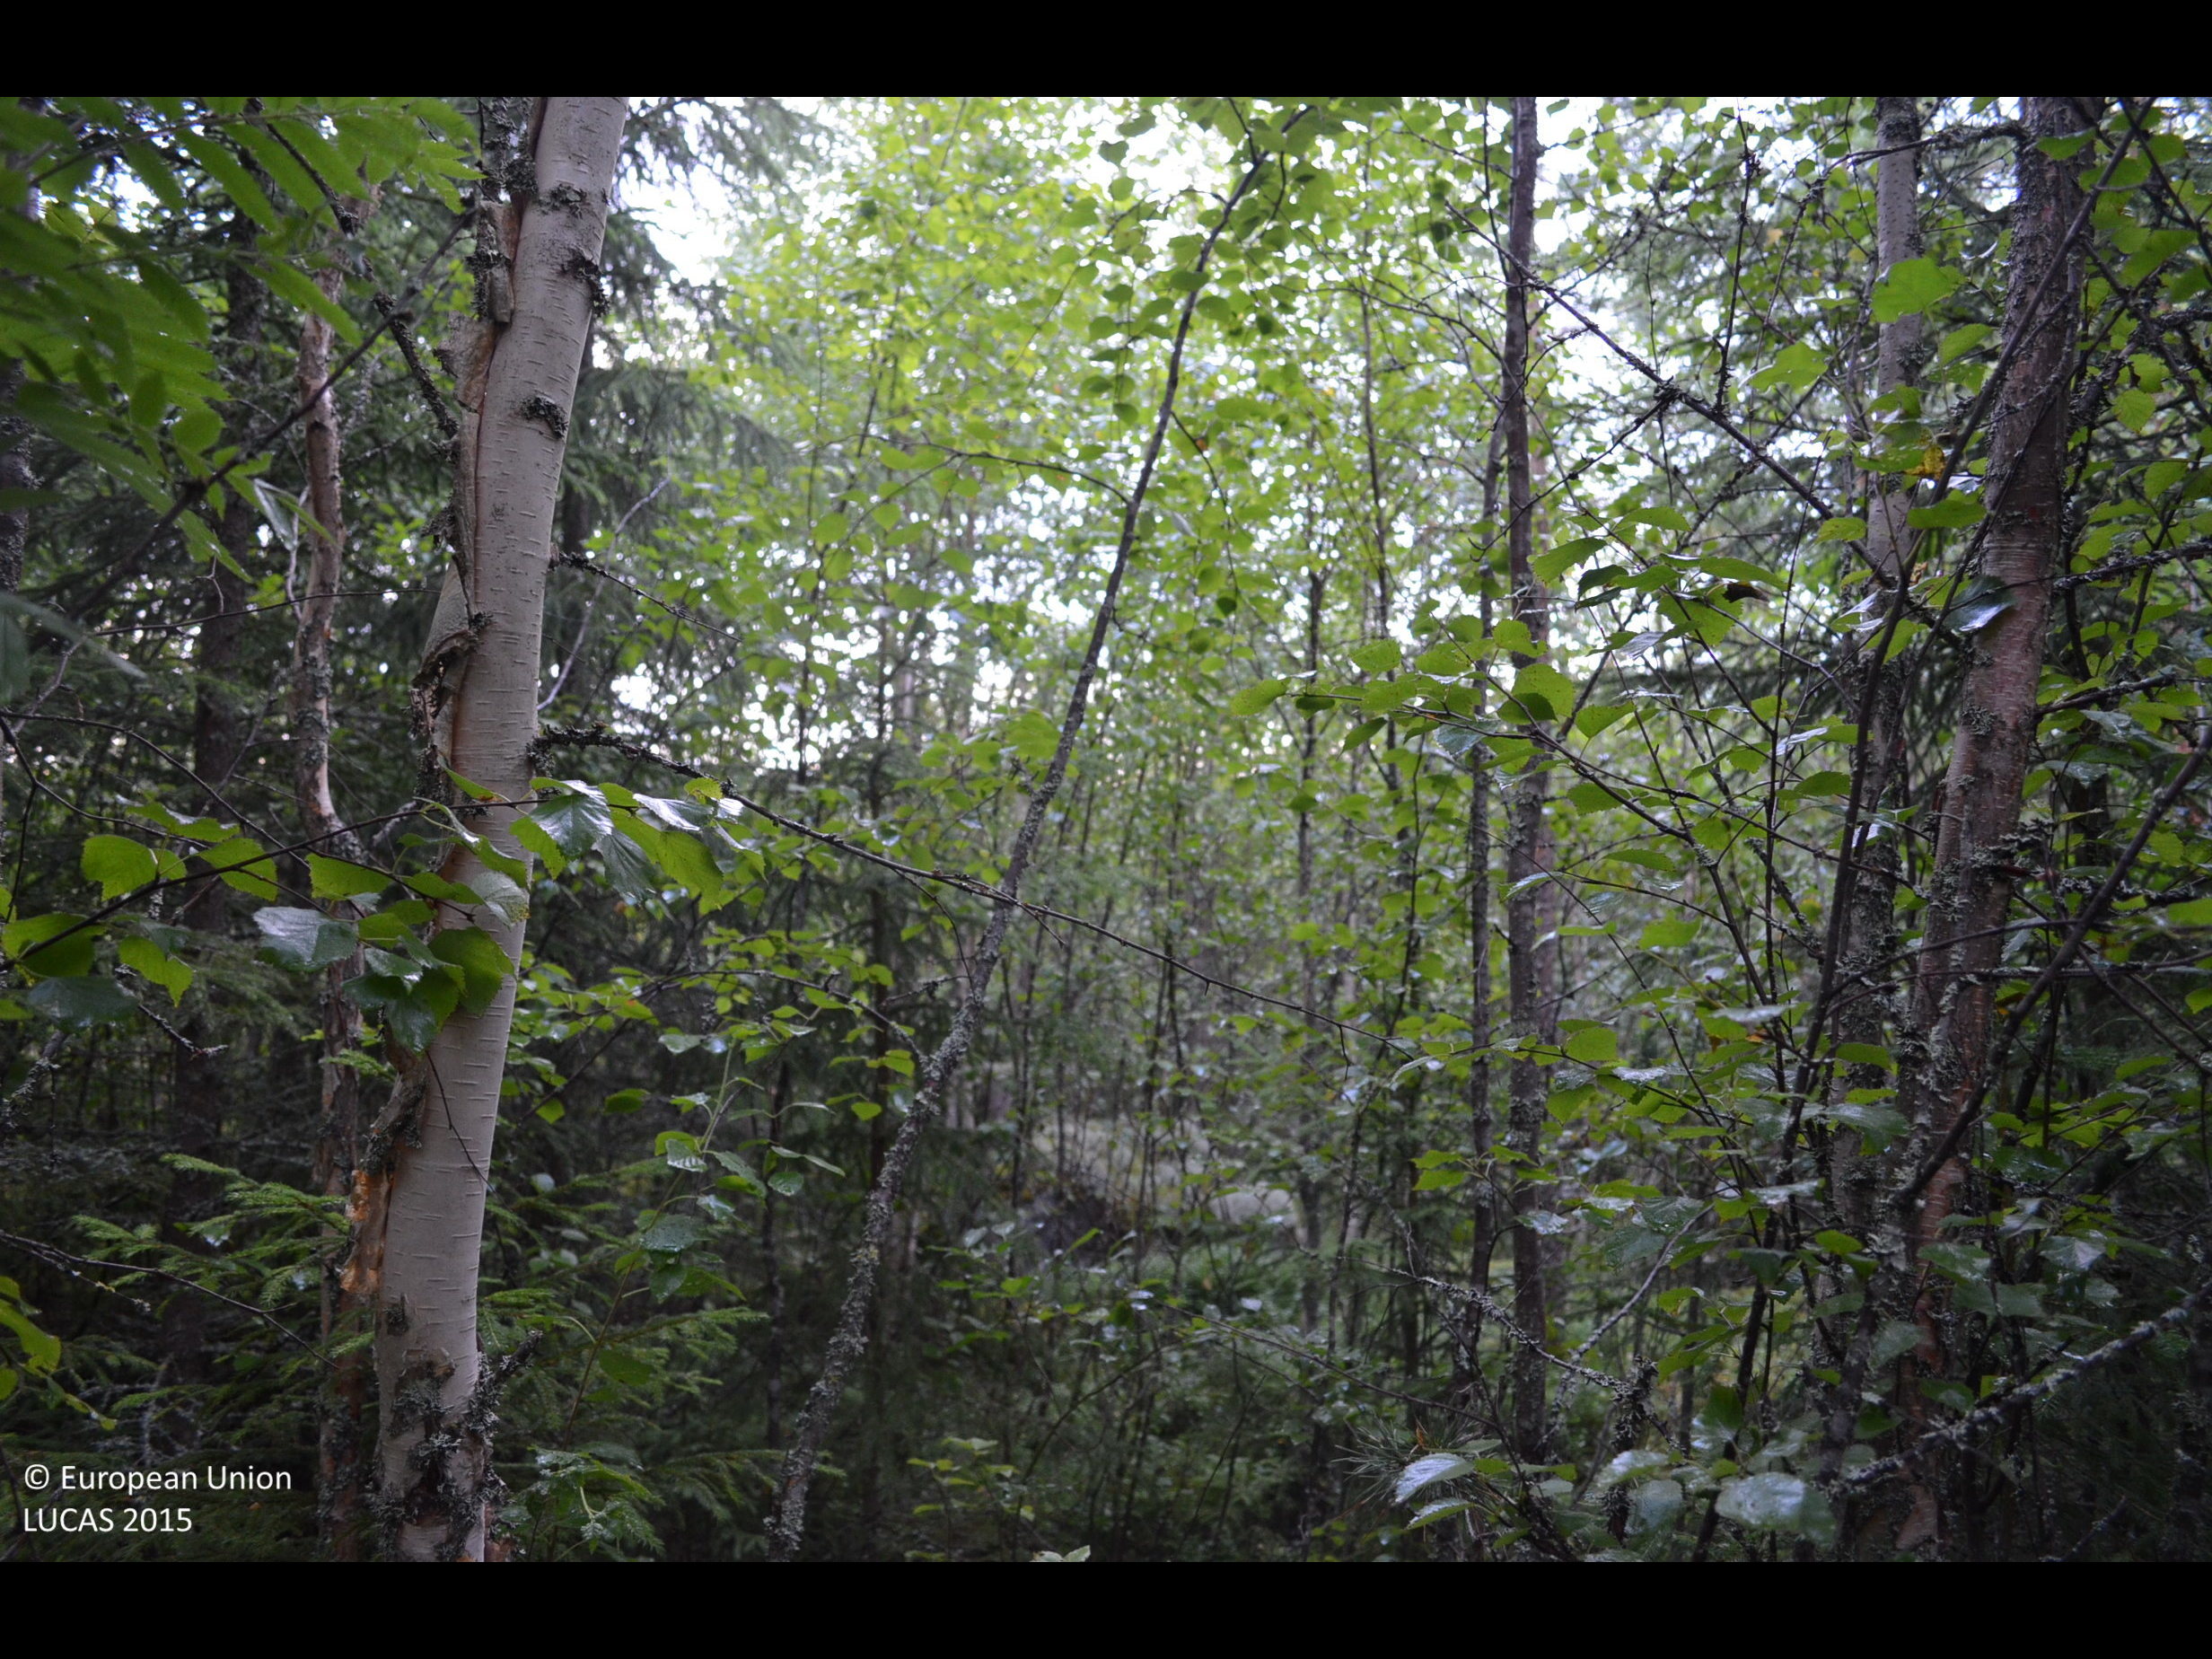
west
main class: Woodland
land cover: Broadleaved woodland
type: boreal forest
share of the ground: > 75 %
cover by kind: broadleaved forest trees 75 %, coniferous forest trees 20 %, herbaceous plants 5 %
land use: Forestry
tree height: > 5 m
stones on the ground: < 10 %
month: July
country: FI
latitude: 61.8988
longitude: 24.1907
